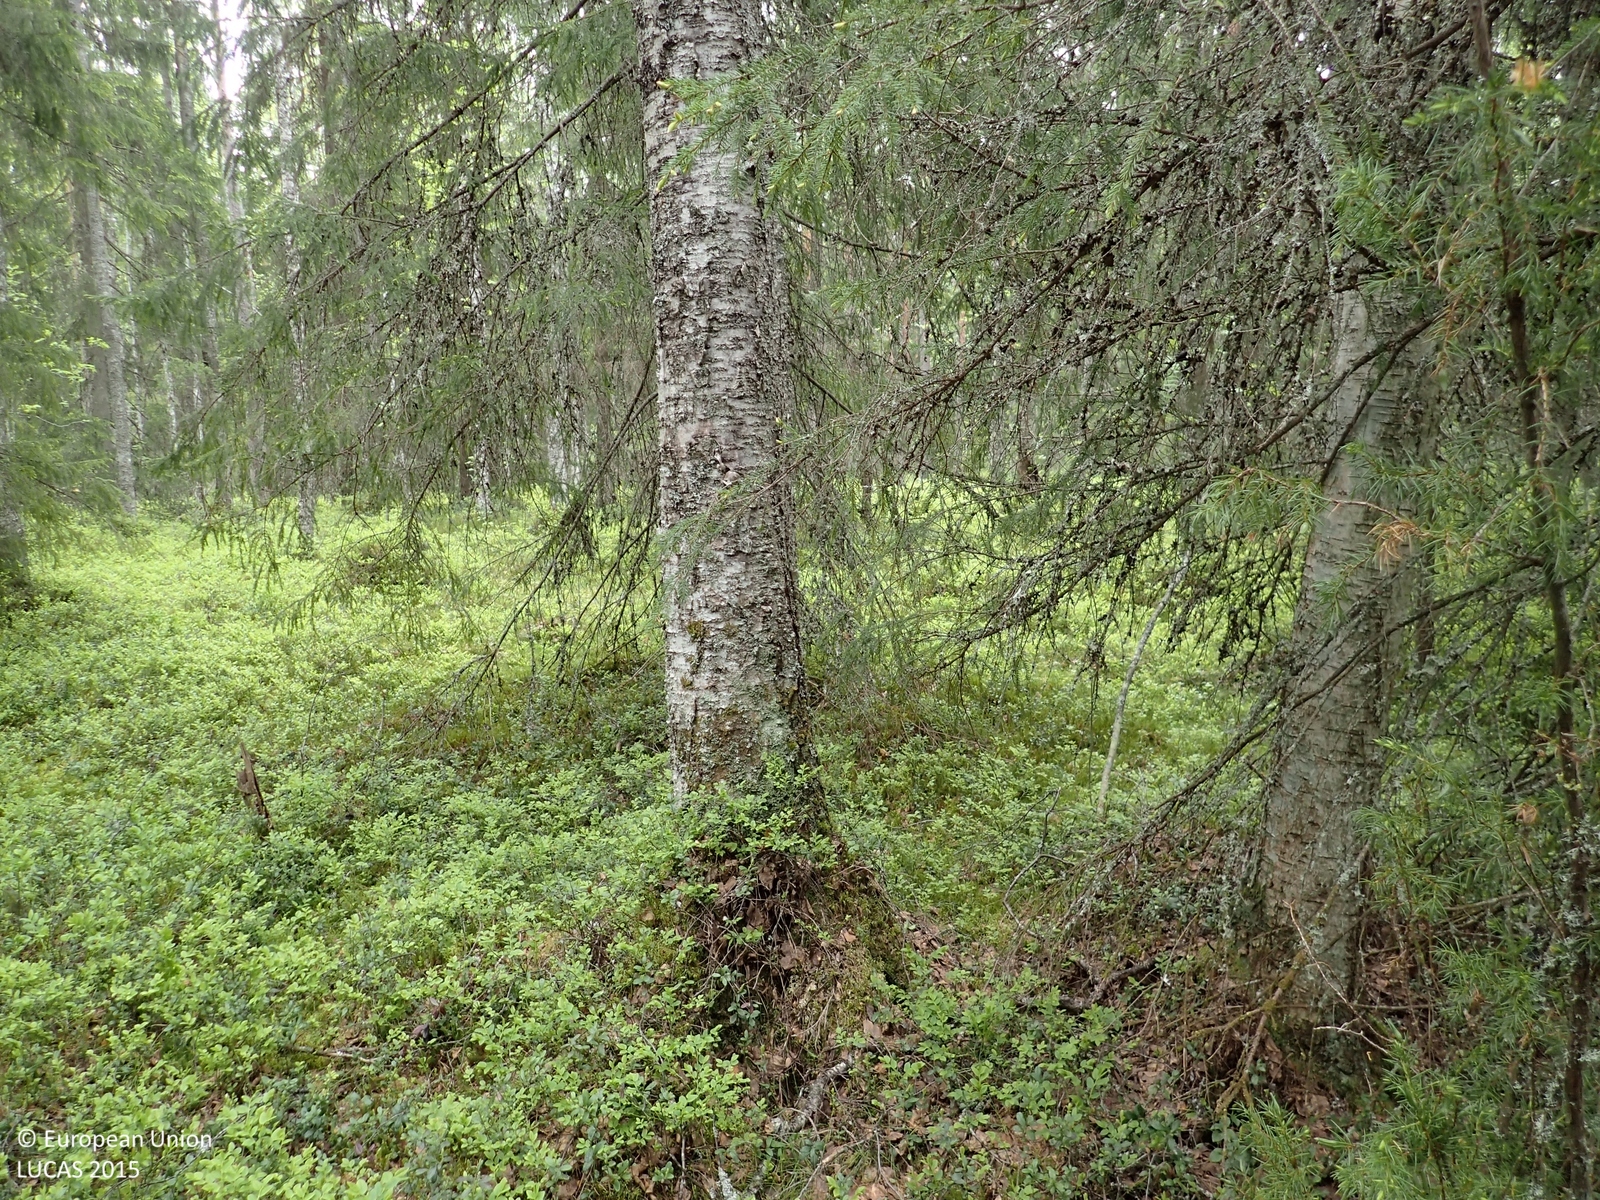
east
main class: Woodland
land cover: Spruce dominated mixed woodland
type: boreal forest
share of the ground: > 75 %
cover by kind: coniferous forest trees 65 %, broadleaved forest trees 25 %, shrubs 10 %
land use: Forestry
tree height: > 5 m
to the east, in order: Spruce dominated mixed woodland; Ditches and canals; Spruce dominated mixed woodland; Ditches and canals; Spruce dominated mixed woodland; Ditches and canals; Spruce dominated mixed woodland; Ditches and canals; Spruce dominated mixed woodland; Ditches and canals; Spruce dominated mixed woodland; Ditches and canals; Spruce dominated mixed woodland
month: June
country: FI
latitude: 62.3023
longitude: 22.5744
